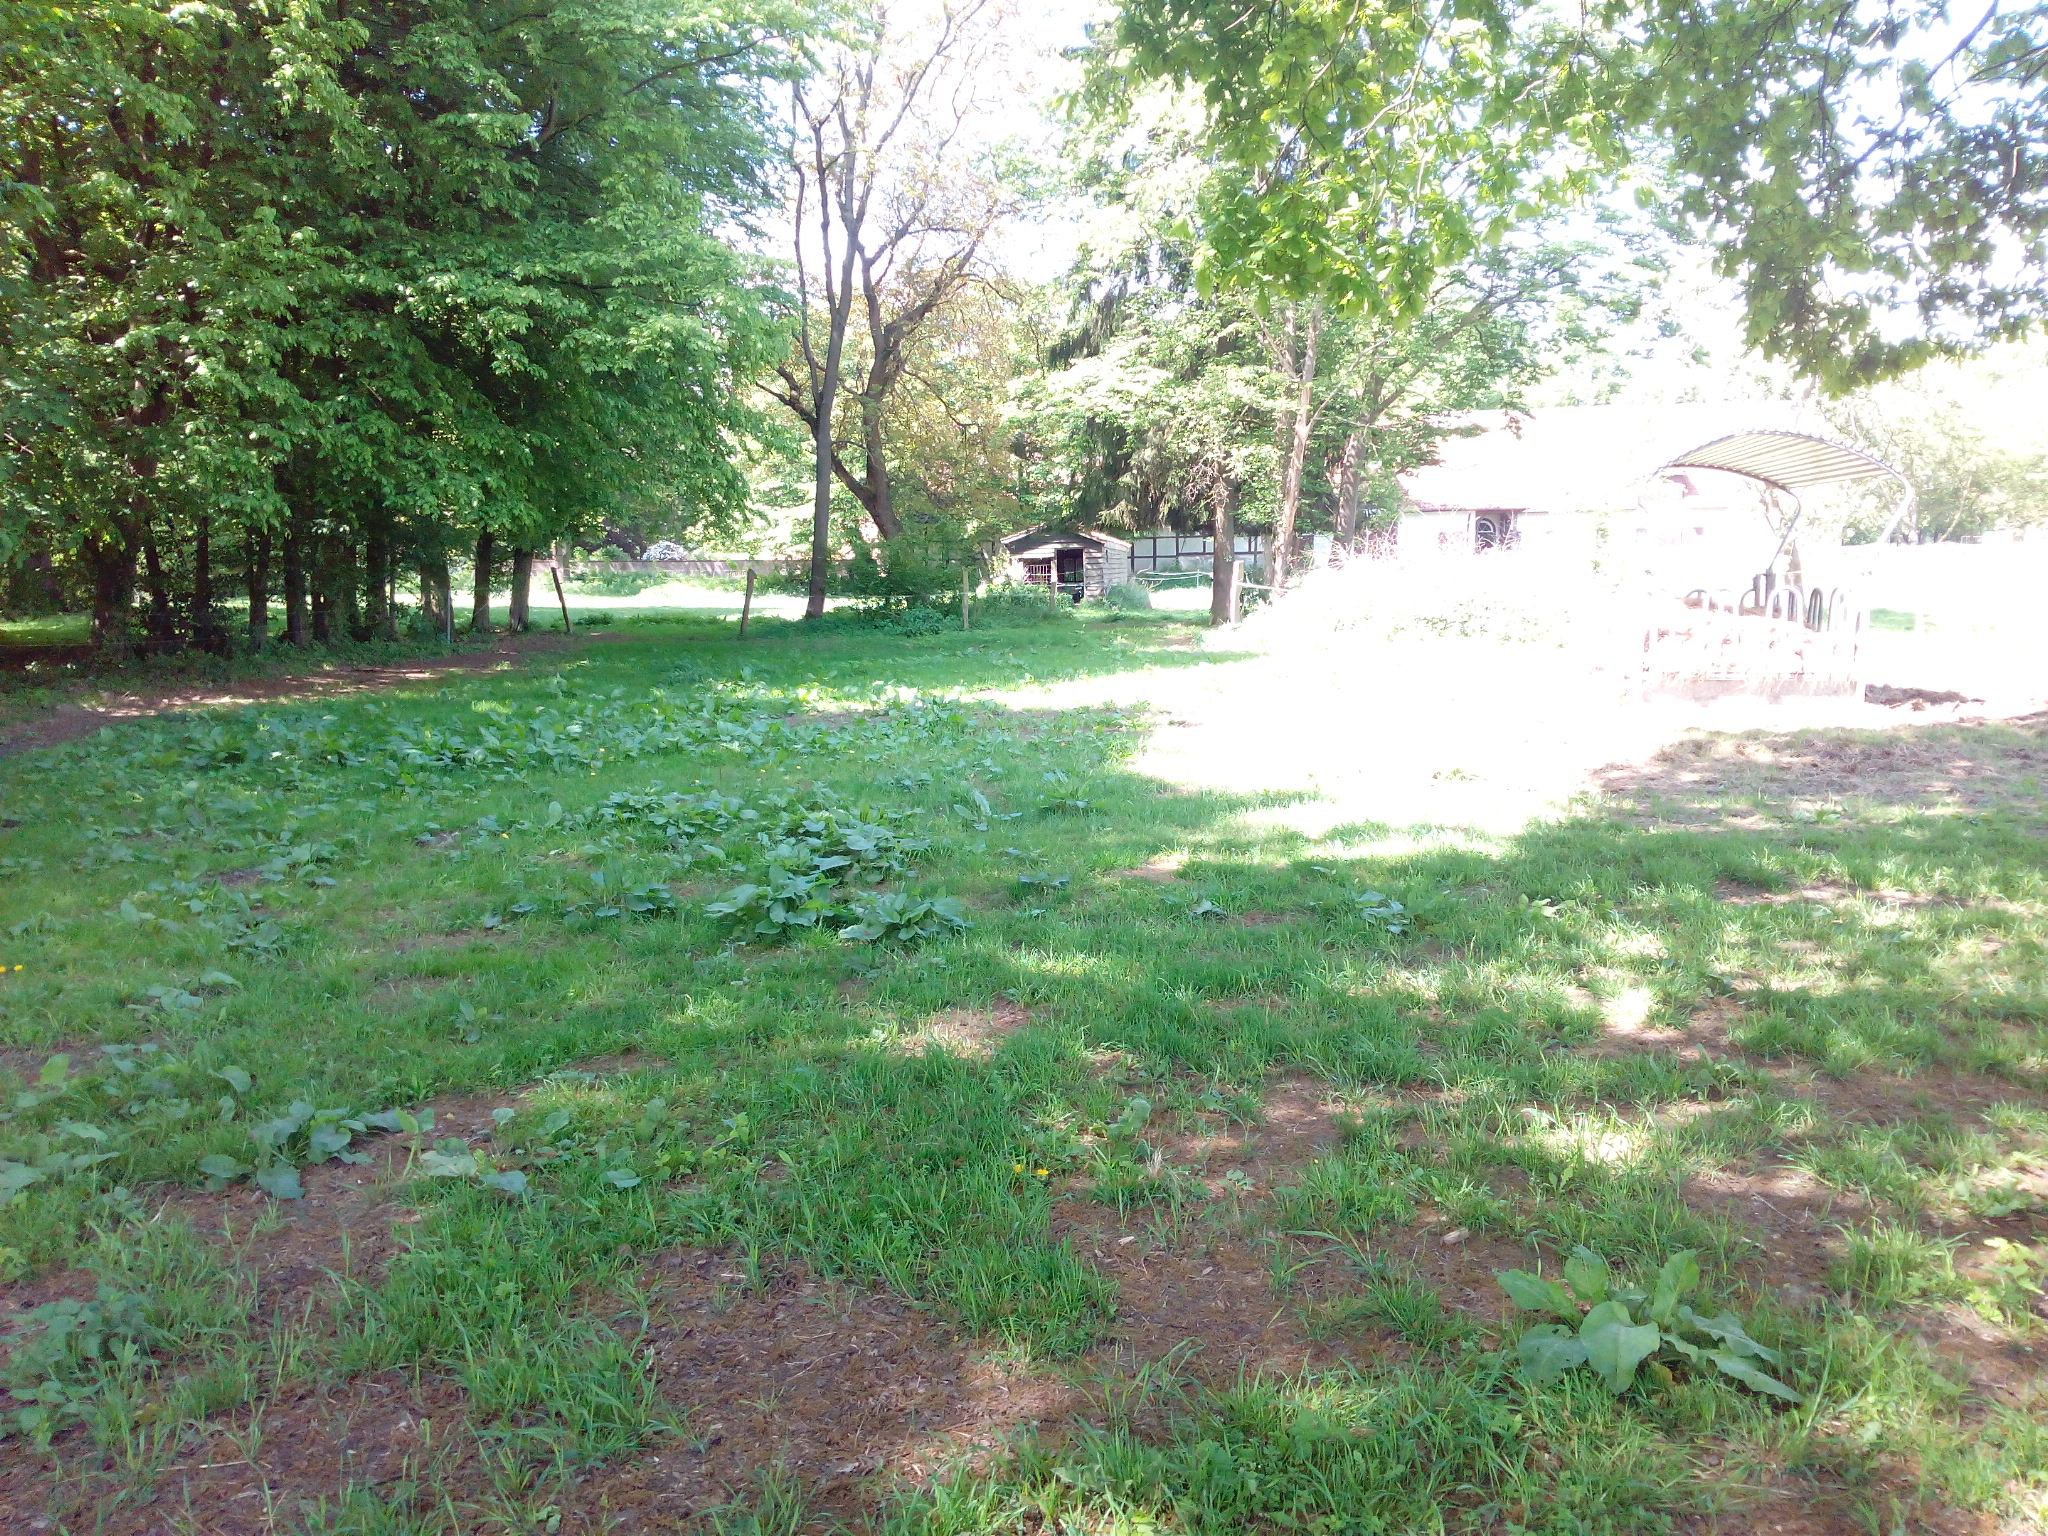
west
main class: Woodland
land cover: Broadleaved woodland
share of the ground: 25 - 50 %
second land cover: Grassland without tree/shrub cover
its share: > 75 %
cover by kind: broadleaved forest trees 60 %, herbaceous plants 40 %
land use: Forestry
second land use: Agriculture (excluding fallow land and kitchen gardens)
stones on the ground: < 10 %
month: May
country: DE
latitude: 52.4668
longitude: 9.6321
